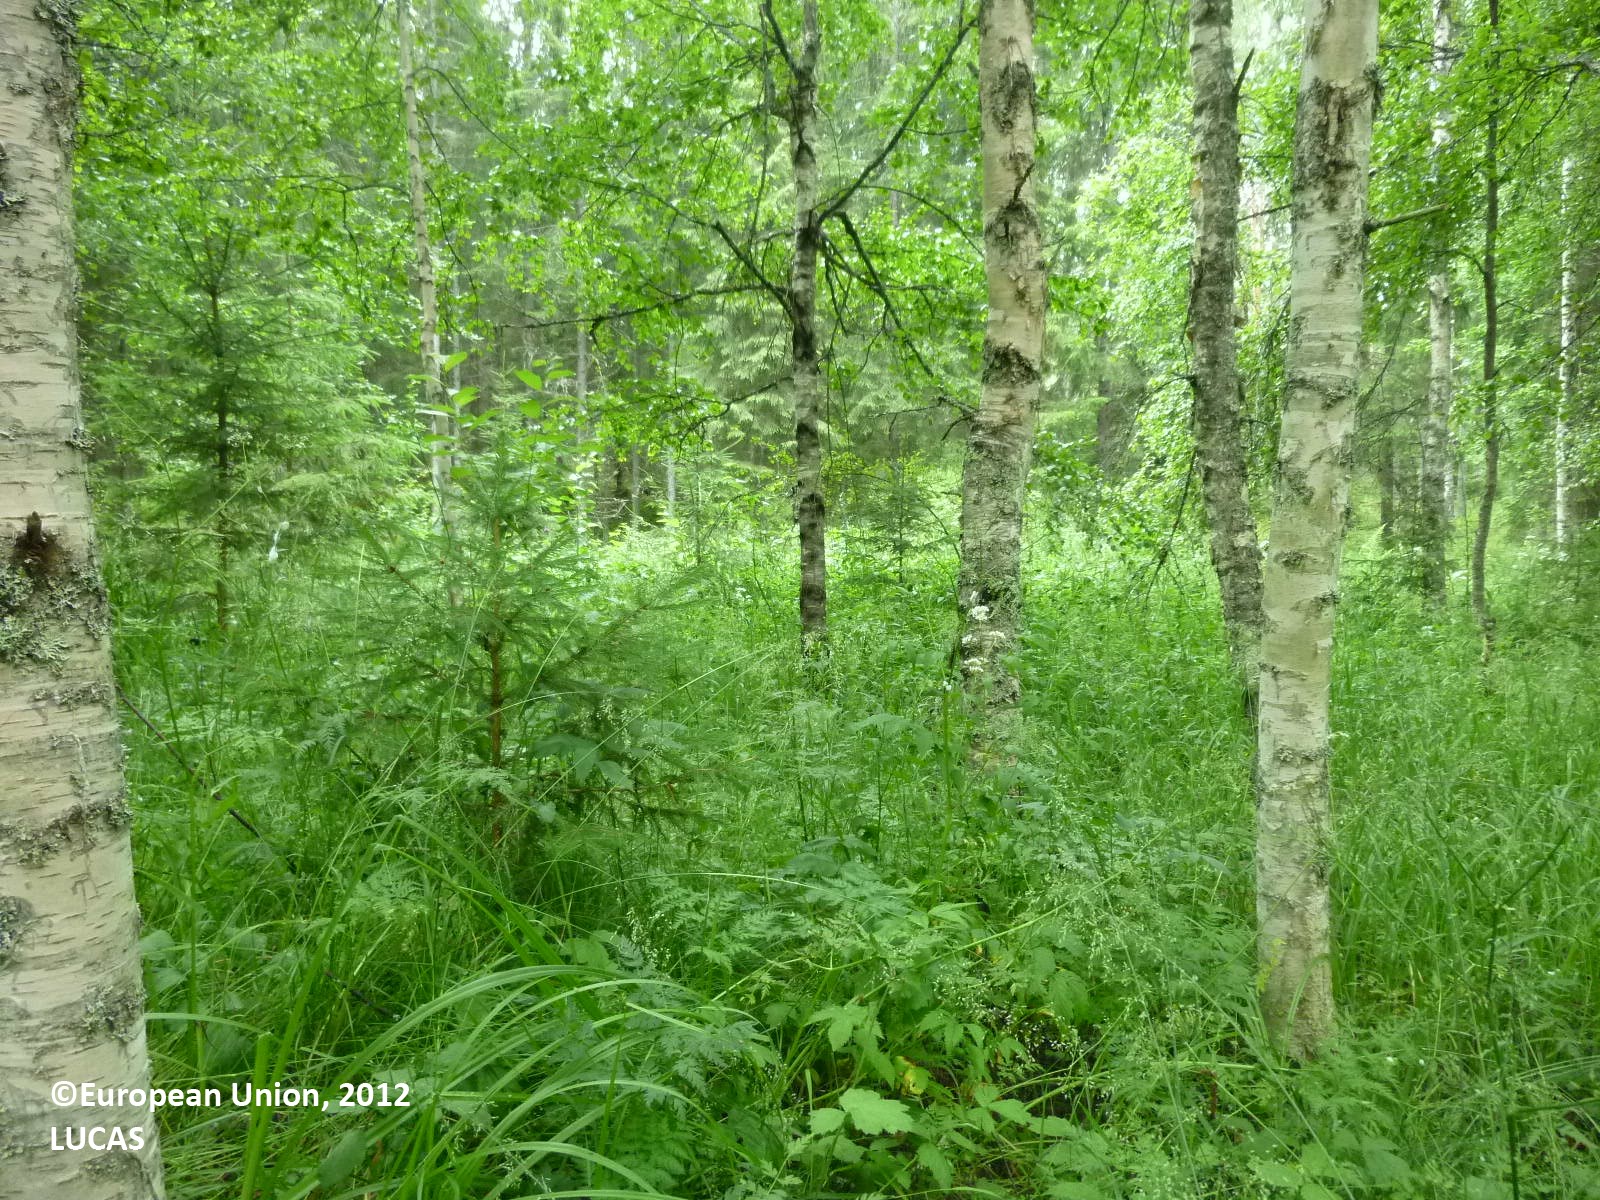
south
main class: Woodland
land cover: Broadleaved woodland
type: boreal forest
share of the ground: > 75 %
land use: Forestry
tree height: > 5 m
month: July
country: FI
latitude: 61.4657
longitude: 22.0870
